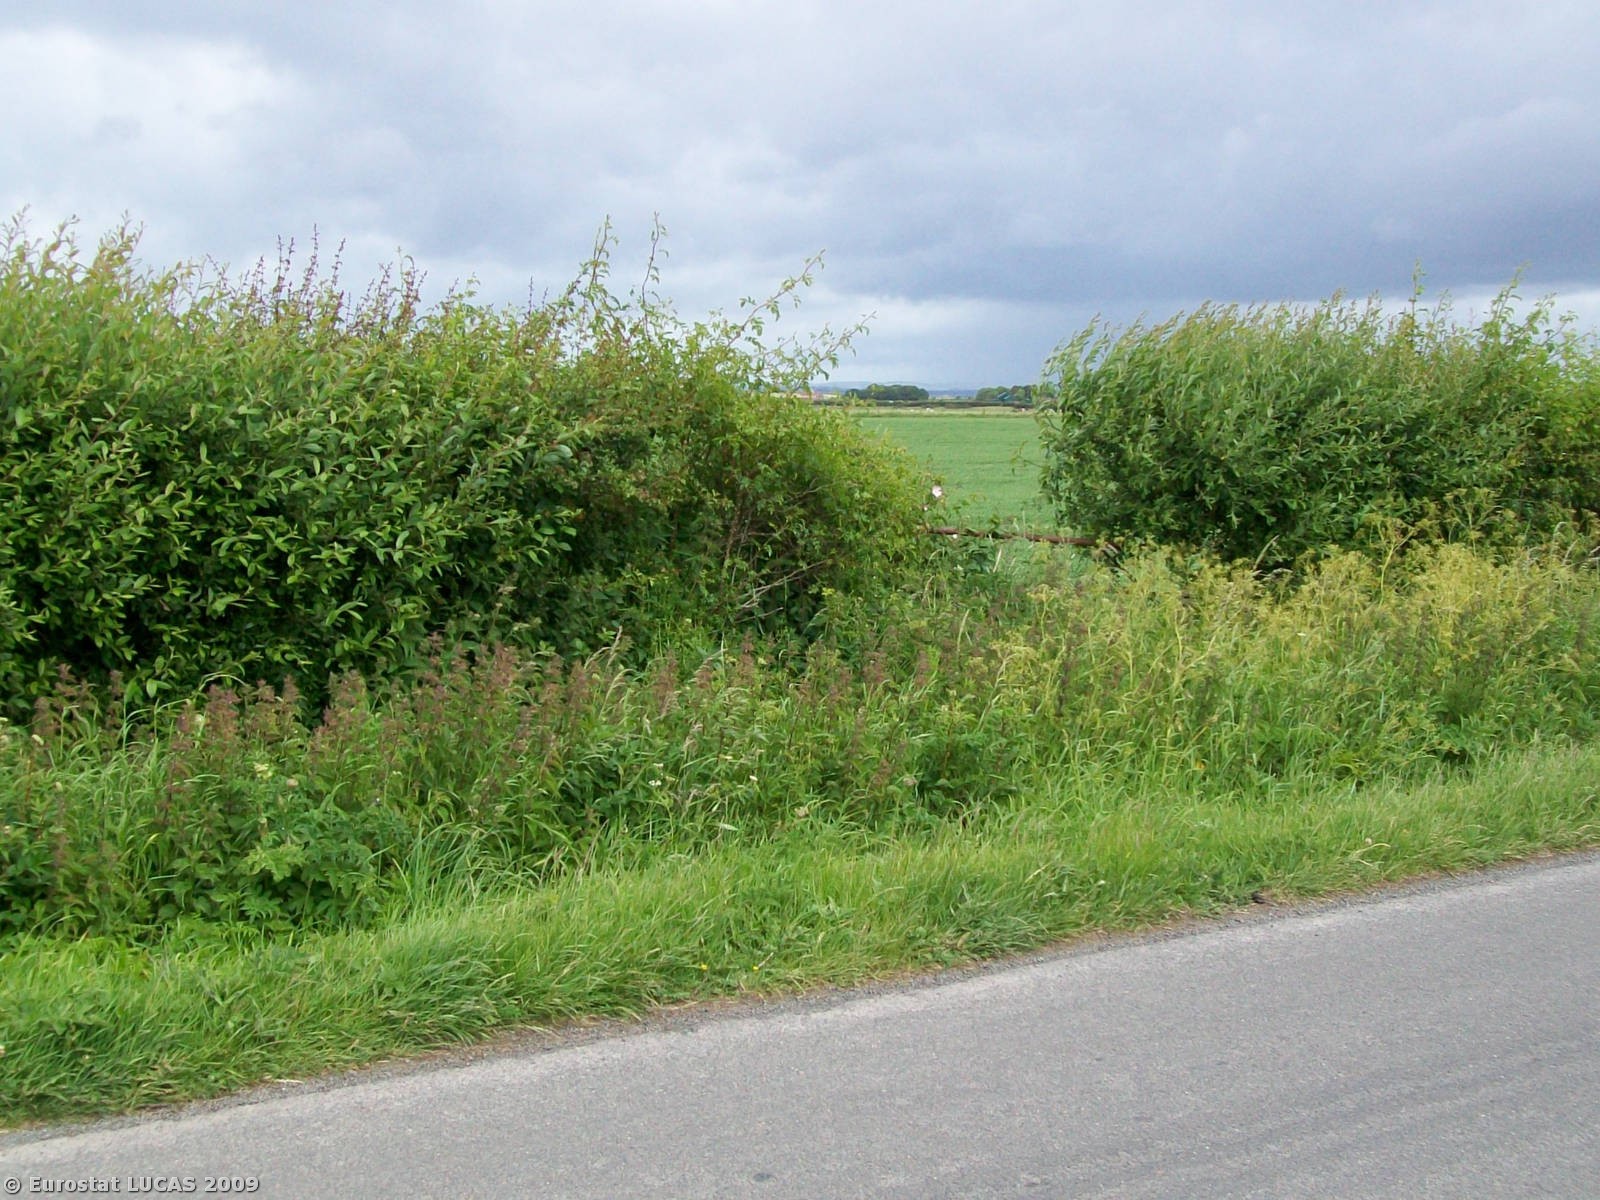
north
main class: Grassland
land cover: Grassland without tree/shrub cover
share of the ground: > 75 %
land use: Road transport
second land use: Unused
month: June
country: GB
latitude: 54.8976
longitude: -3.2207
